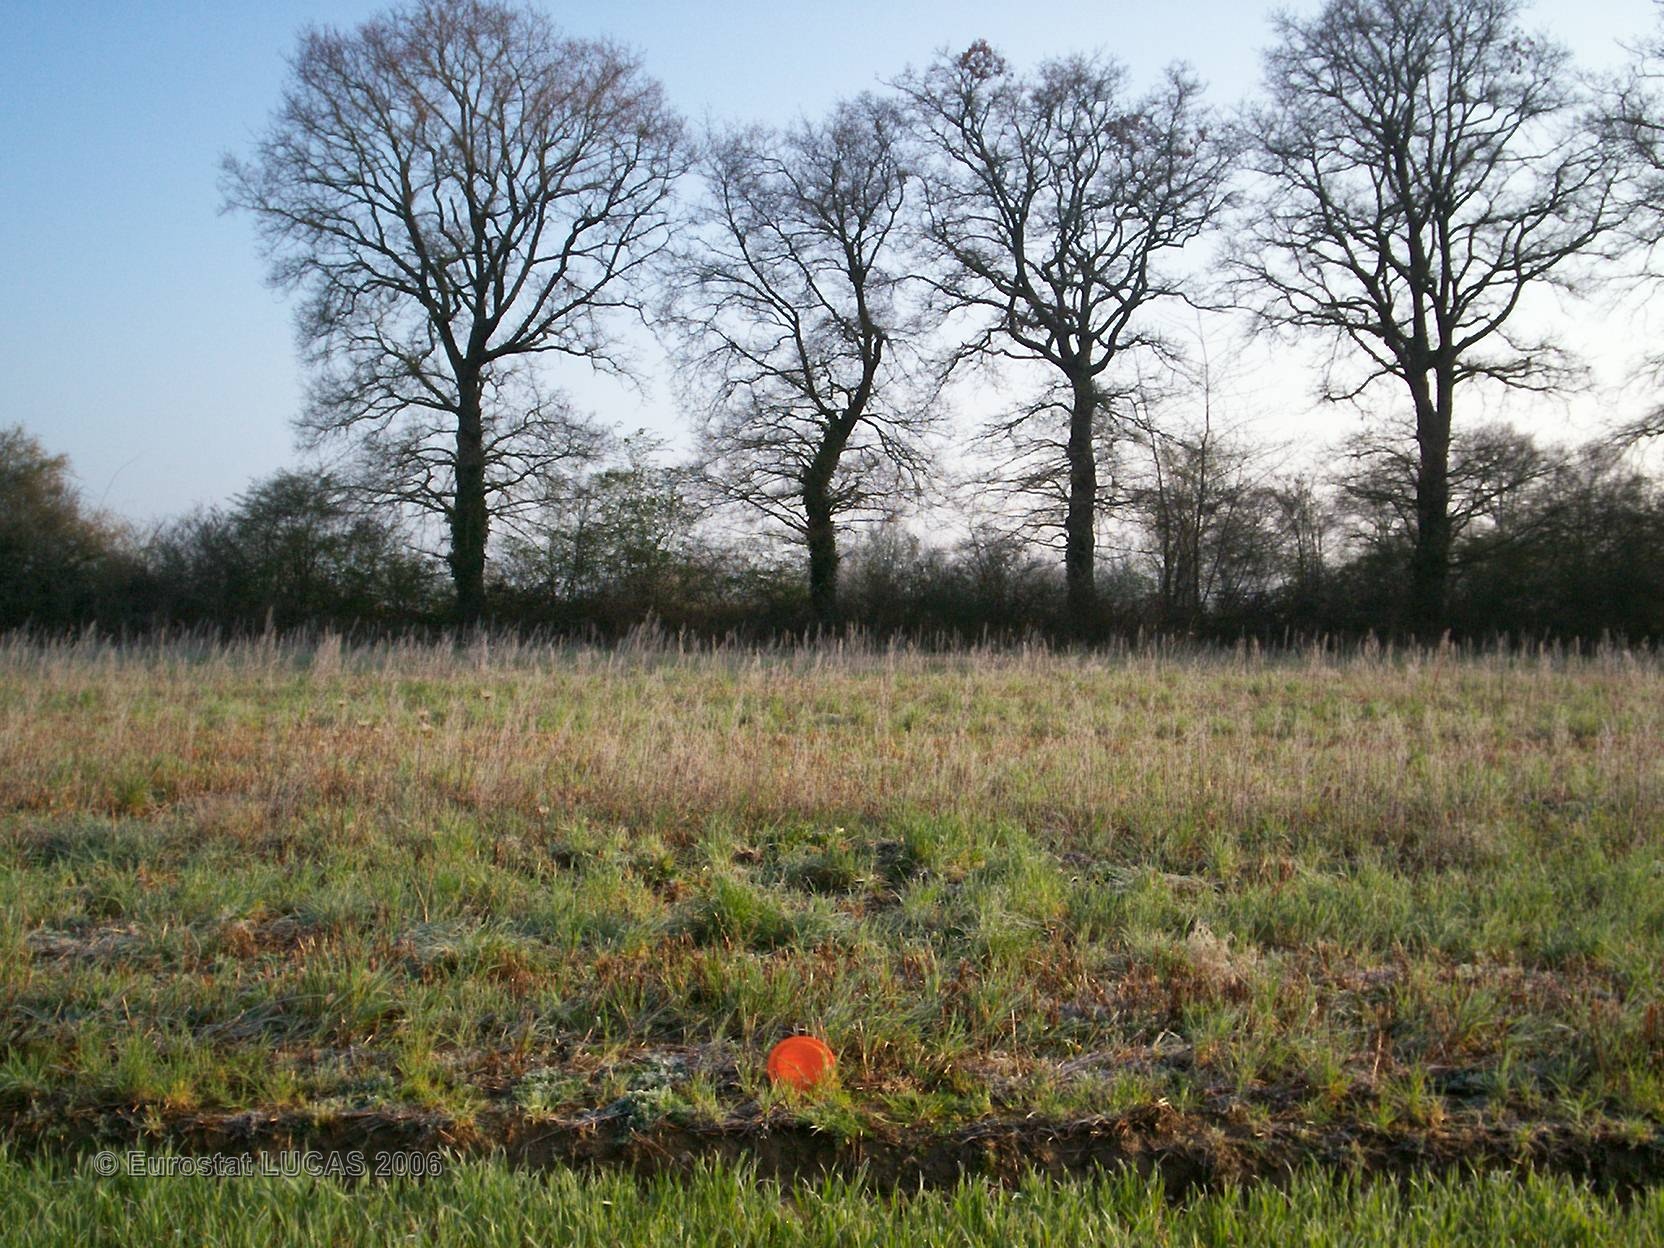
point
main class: Grassland
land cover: Grassland without tree/shrub cover
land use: Agriculture (excluding fallow land and kitchen gardens)
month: April
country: FR
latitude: 46.2315
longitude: 1.0799
